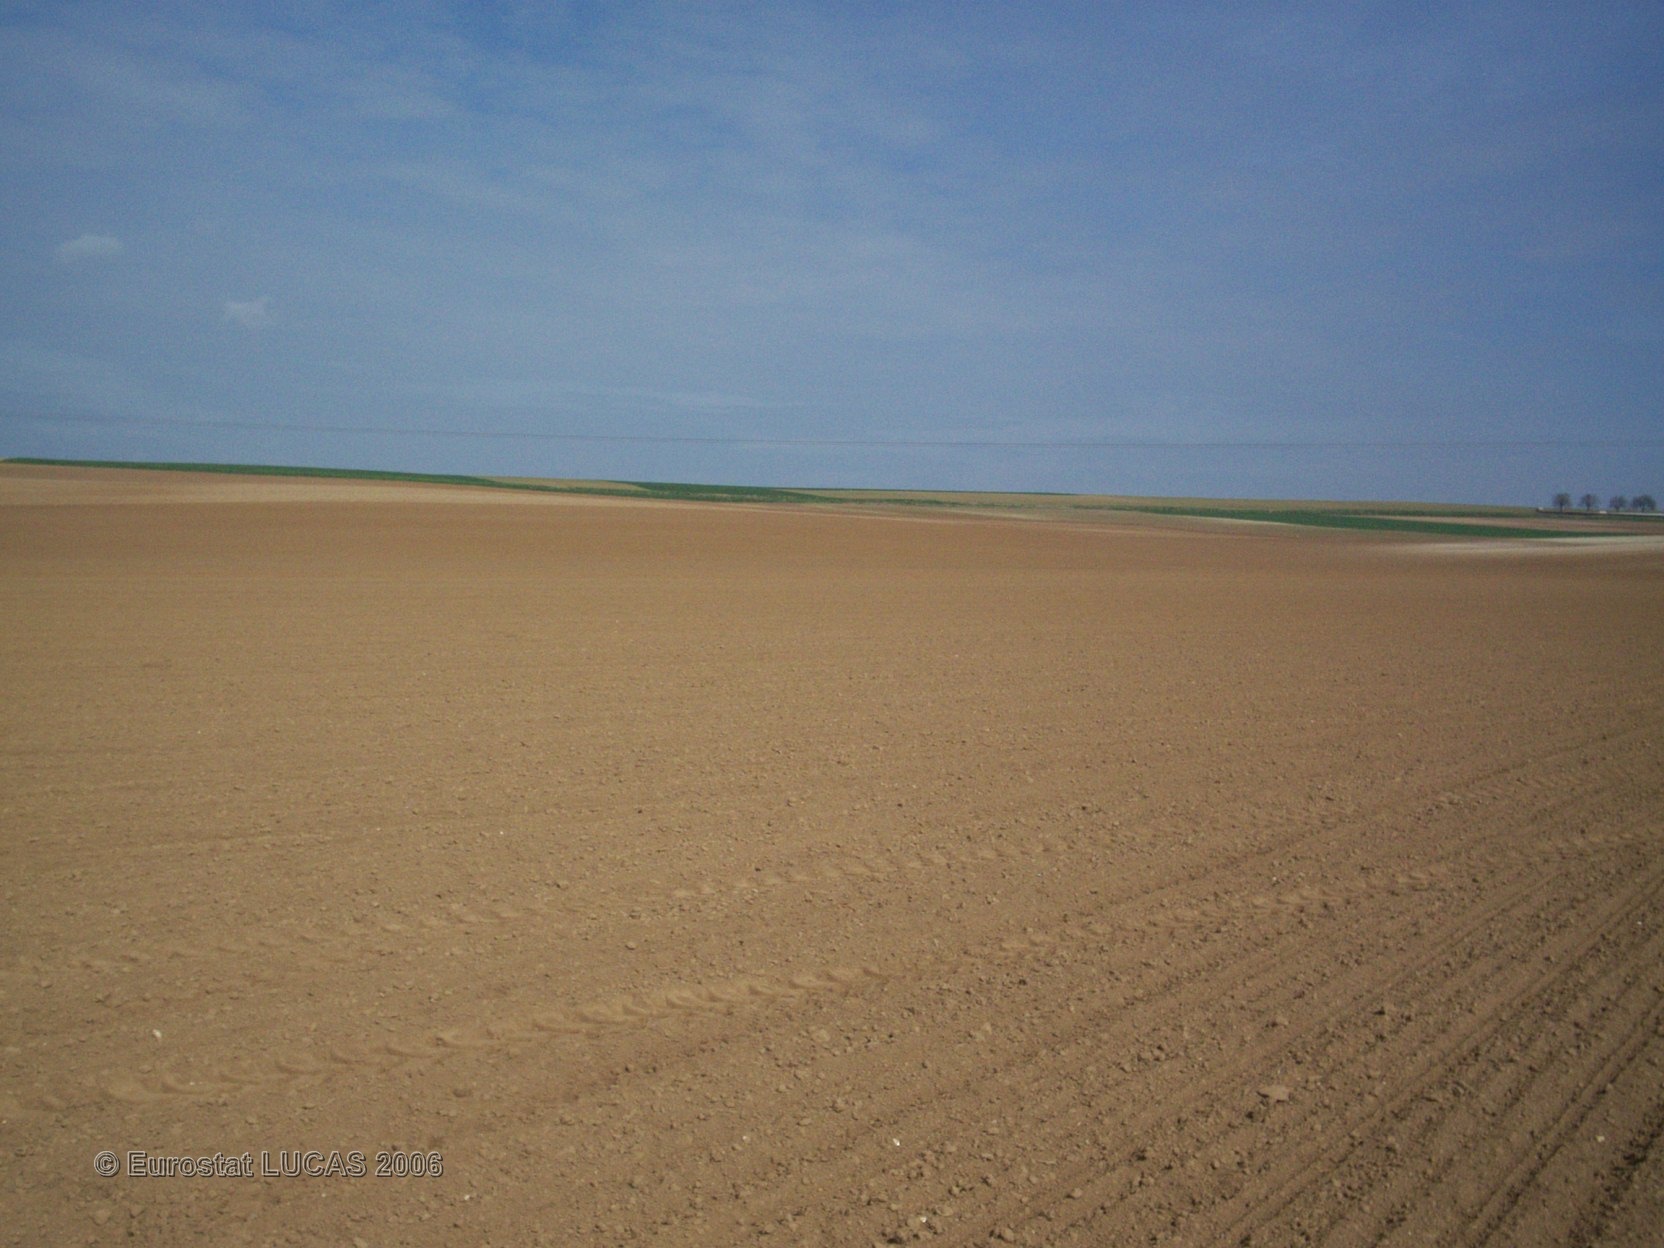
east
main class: Cropland
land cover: Sugar beet
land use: Agriculture (excluding fallow land and kitchen gardens)
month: April
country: FR
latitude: 50.0216
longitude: 2.6889
